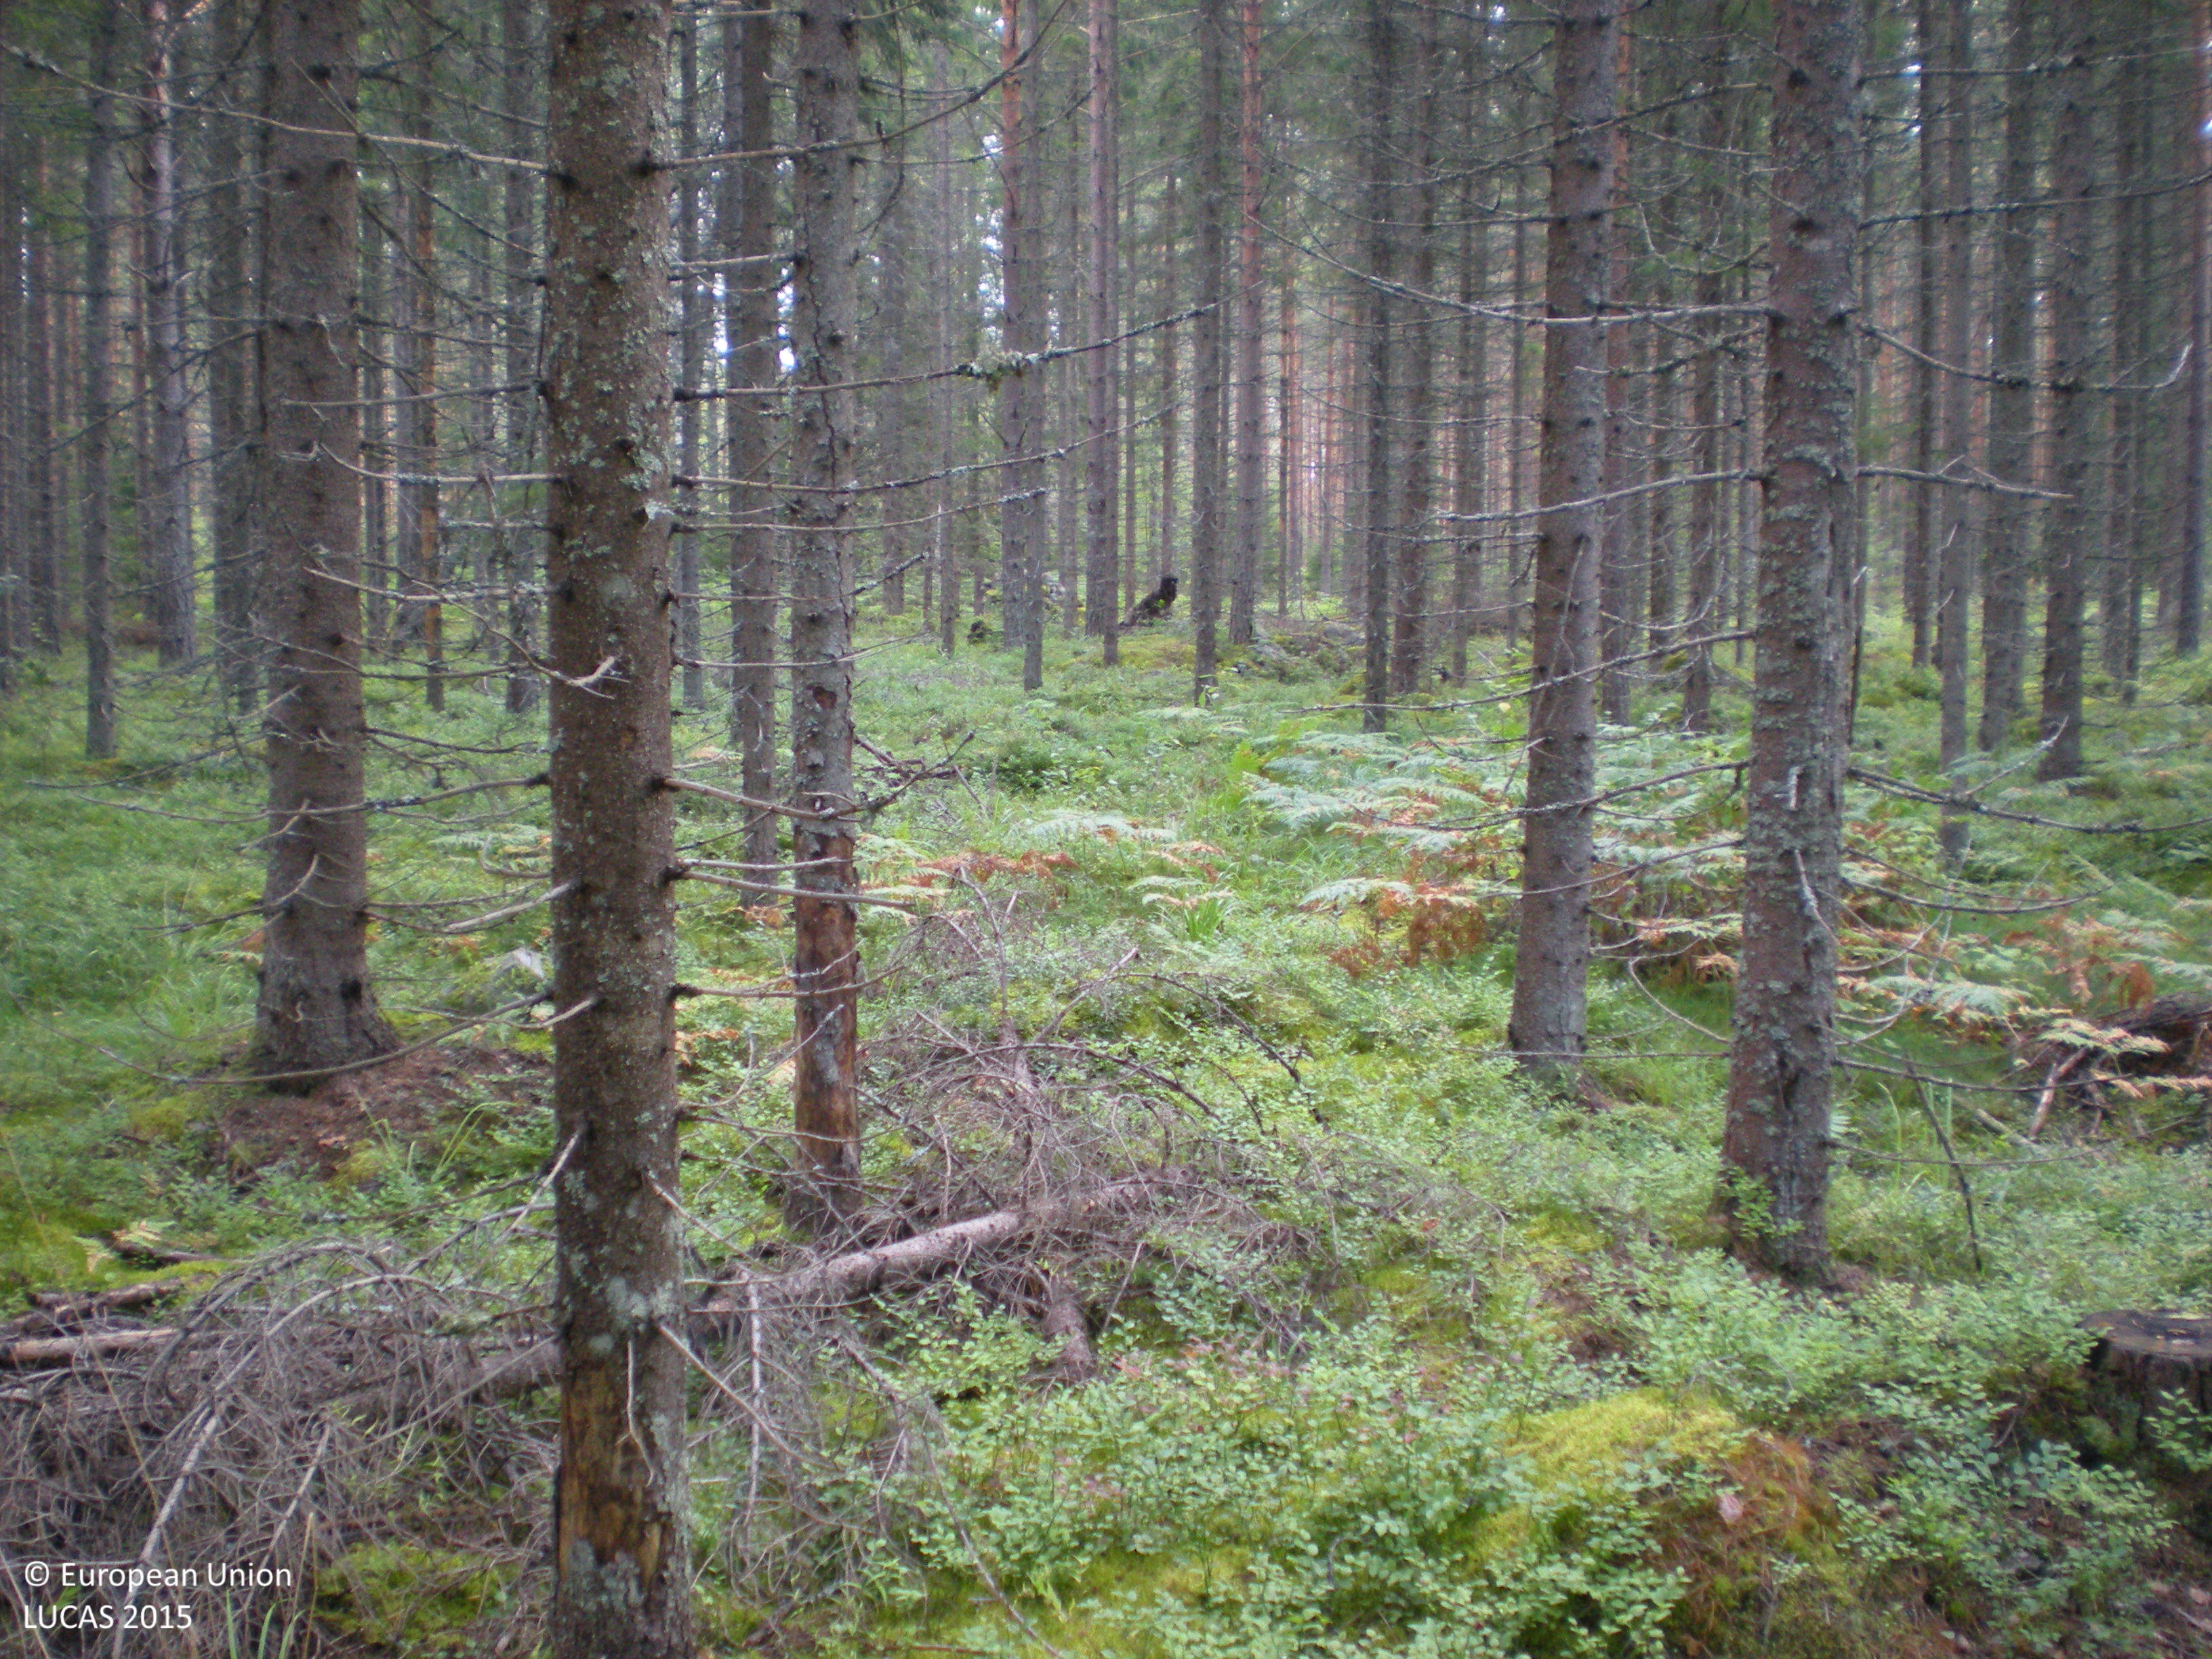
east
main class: Woodland
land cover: Other coniferous woodland
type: boreal forest
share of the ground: > 75 %
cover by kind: coniferous forest trees 75 %, shrubs 15 %, herbaceous plants 5 %, lichens and mosses 5 %
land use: Forestry
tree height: > 5 m
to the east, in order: Other coniferous woodland; Pine dominated coniferous woodland; Other coniferous woodland; Spruce dominated coniferous woodland
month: August
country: SE
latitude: 60.4898
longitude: 17.1059
